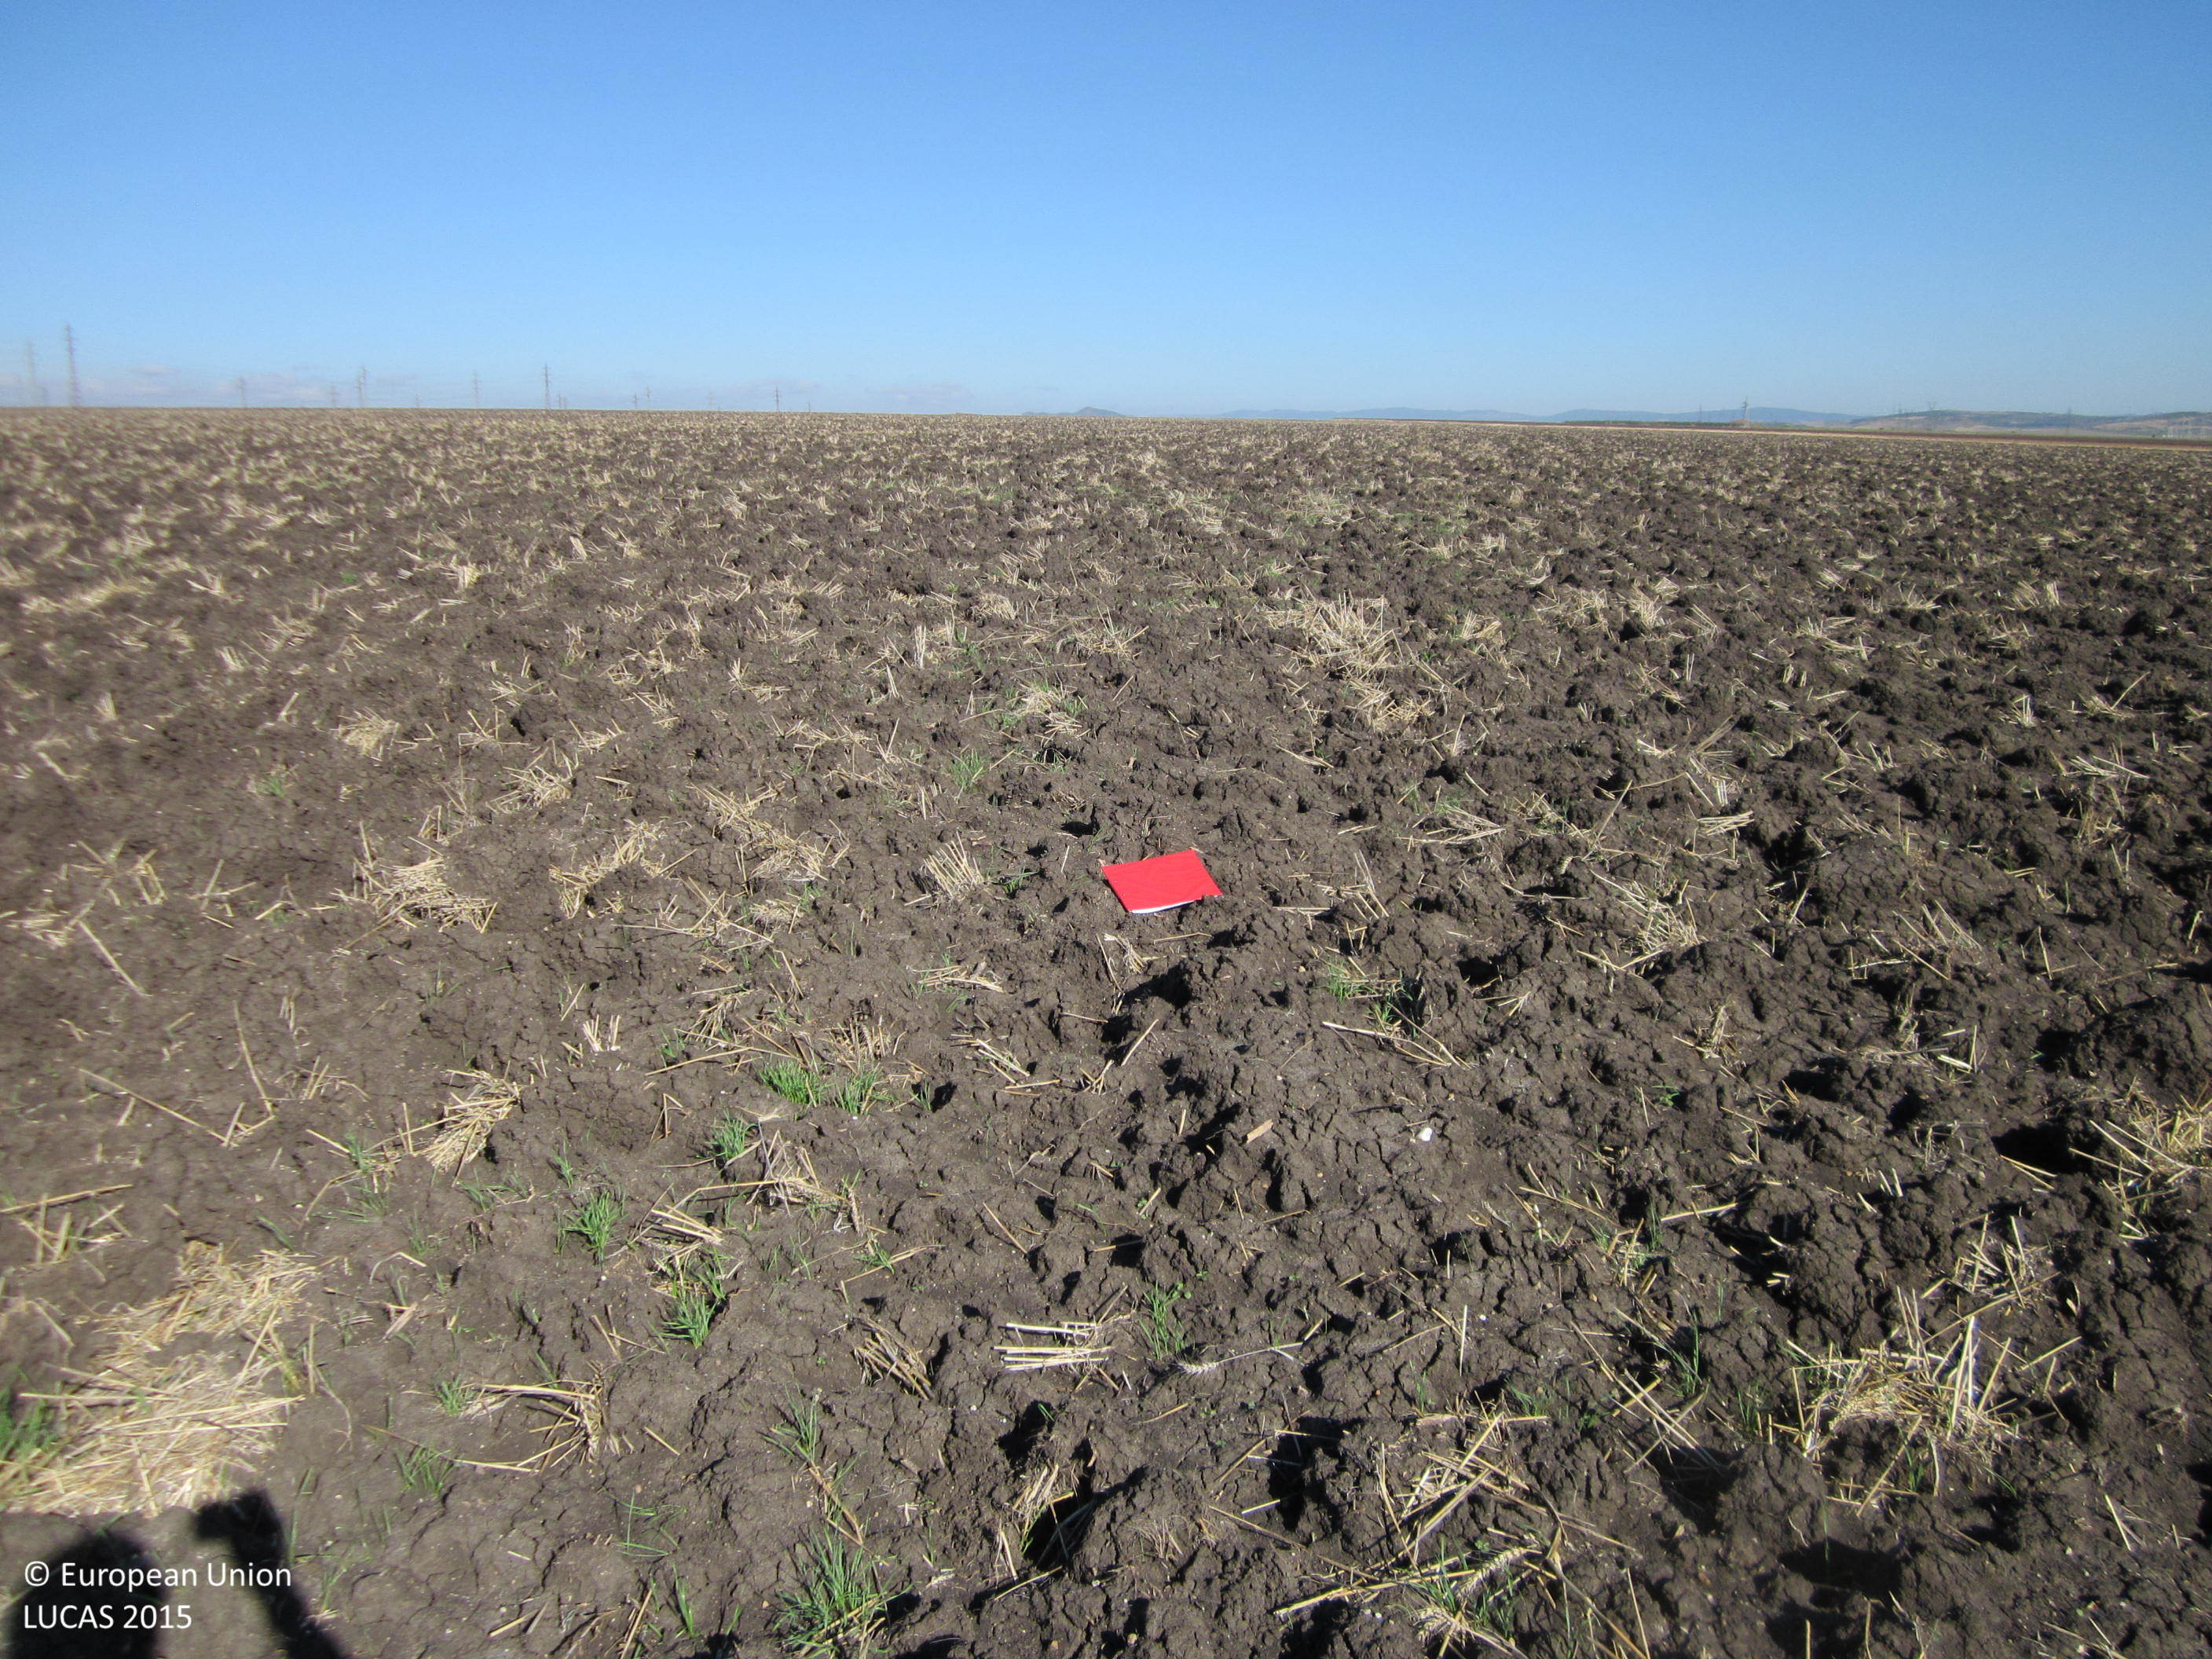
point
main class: Cropland
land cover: Common wheat
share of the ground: < 10 %
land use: Agriculture (excluding fallow land and kitchen gardens)
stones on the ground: < 10 %
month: September
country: BG
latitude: 42.5621
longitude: 27.3501
